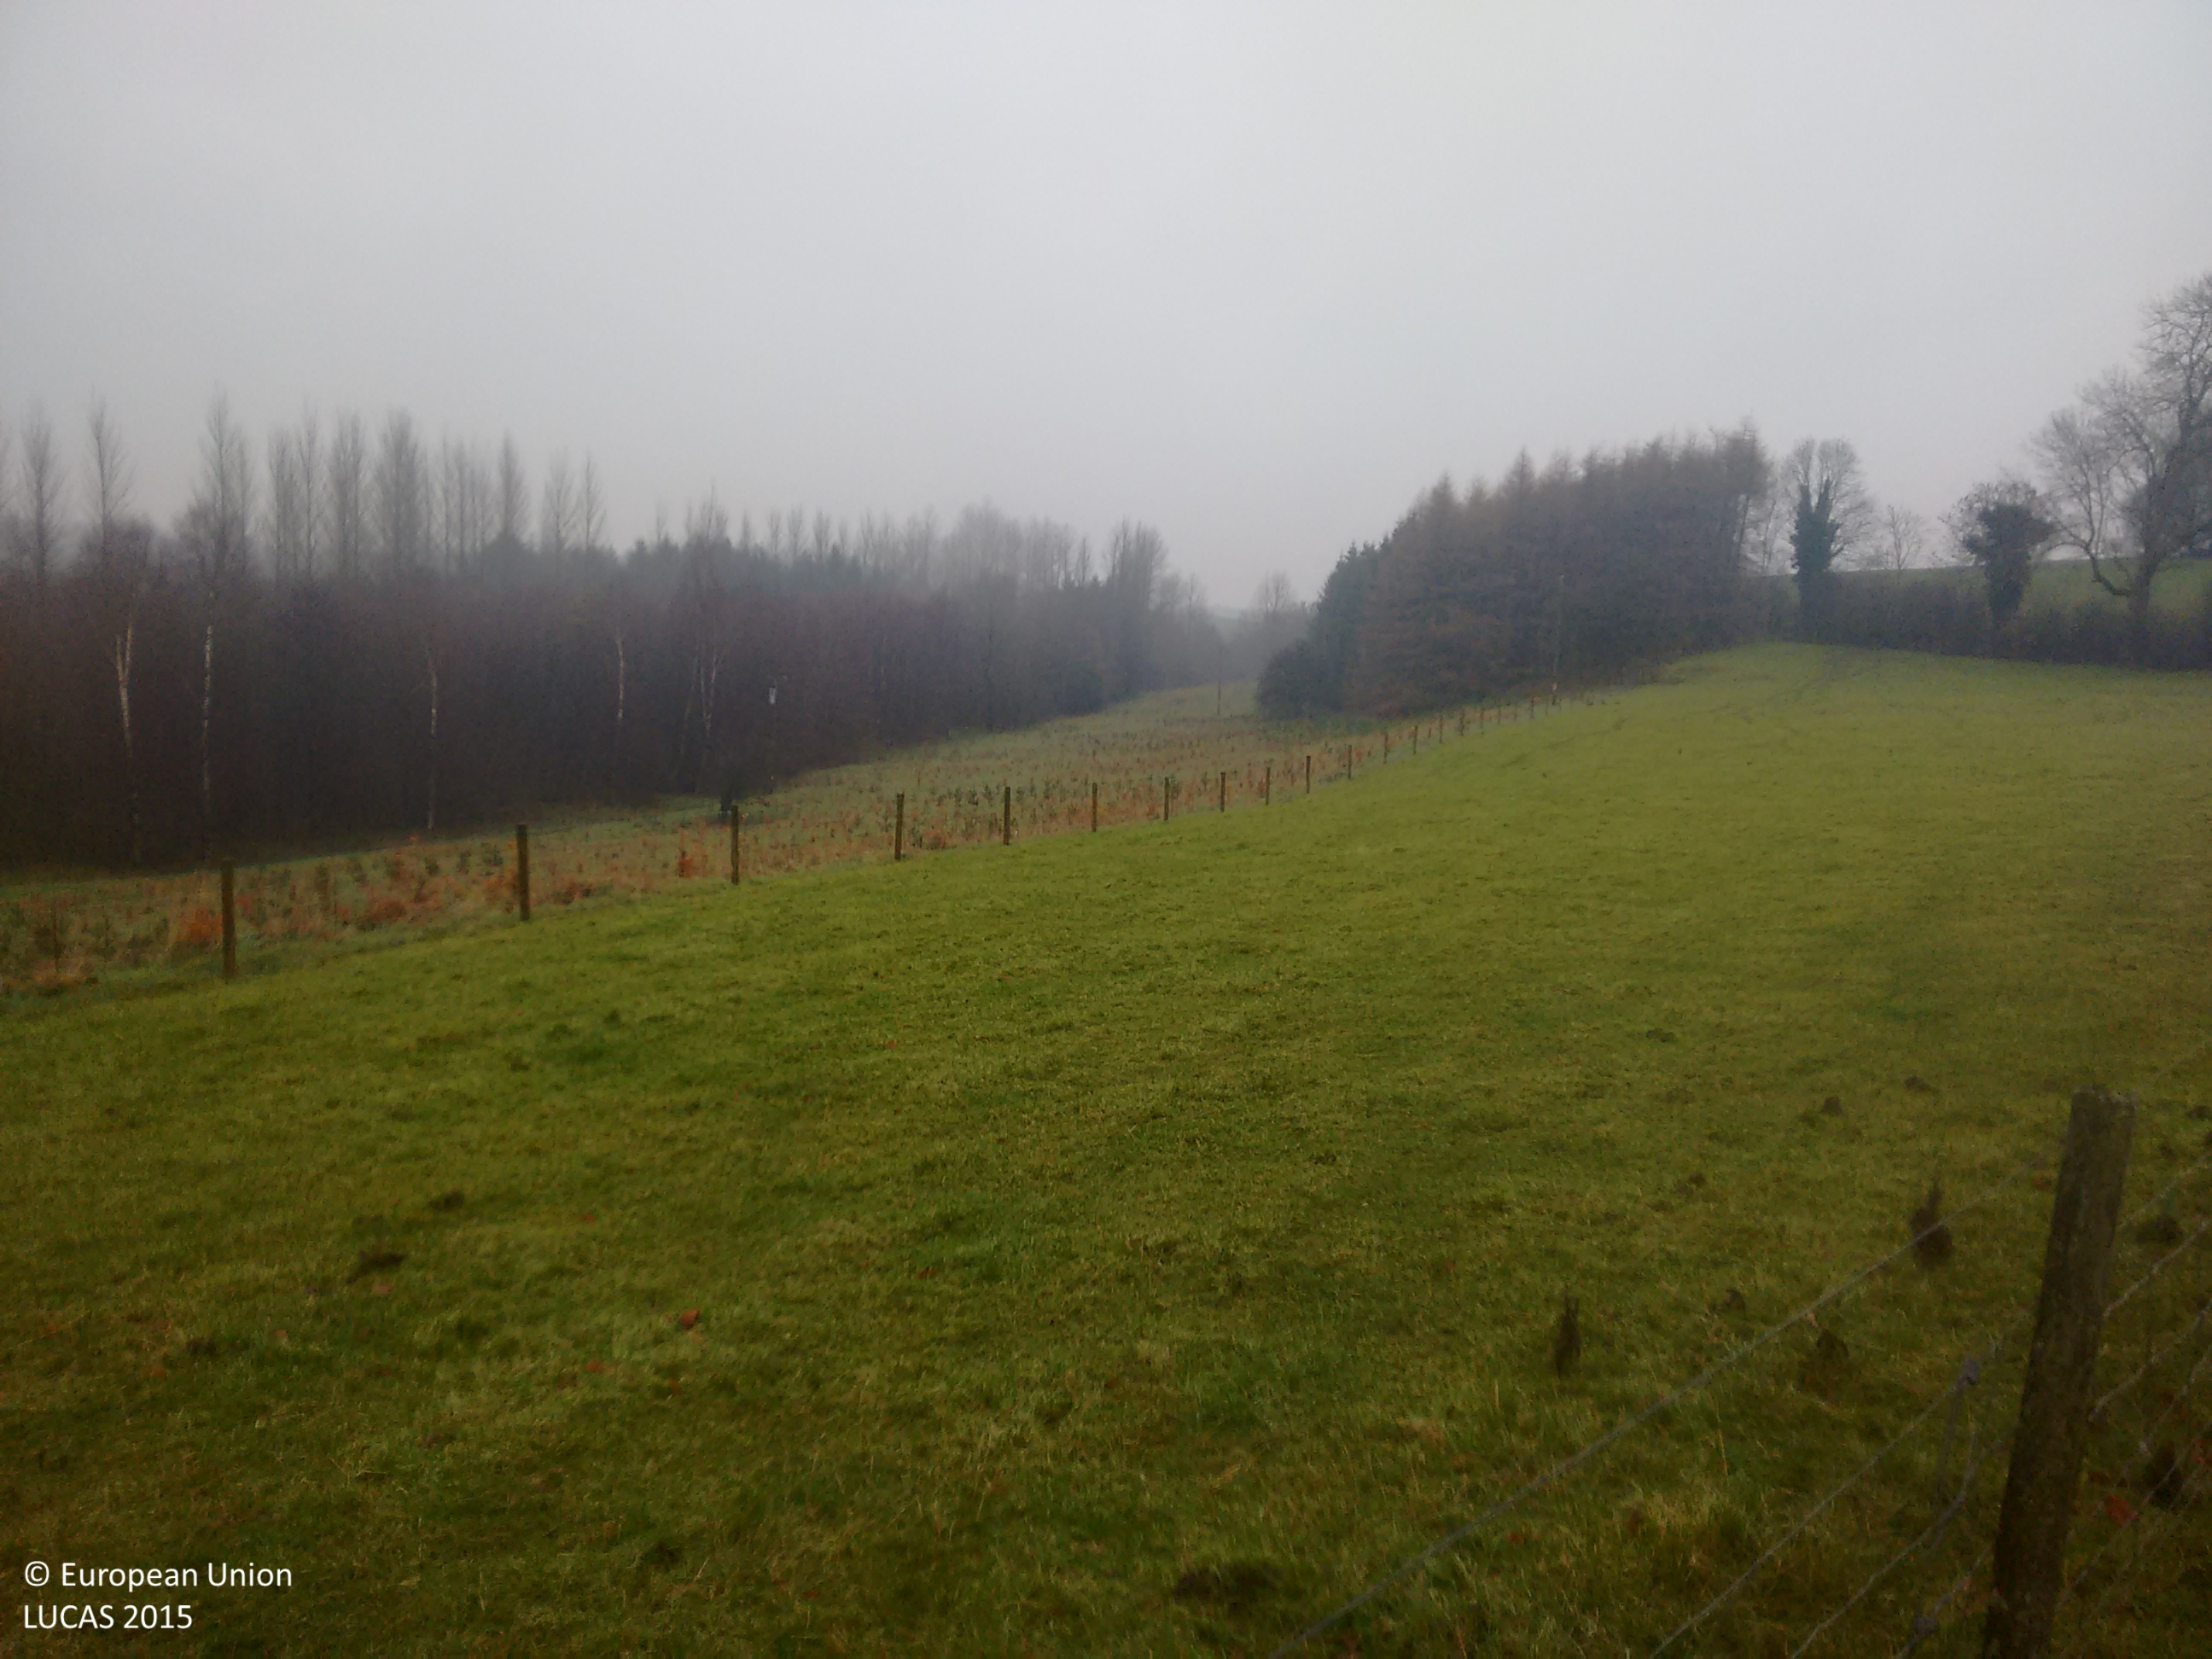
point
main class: Woodland
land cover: Other mixed woodland
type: boreal forest
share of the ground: > 75 %
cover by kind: broadleaved forest trees 60 %, coniferous forest trees 40 %
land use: Semi-natural and natural areas not in use
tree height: > 5 m
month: December
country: IE
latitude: 54.1398
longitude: -7.2463
